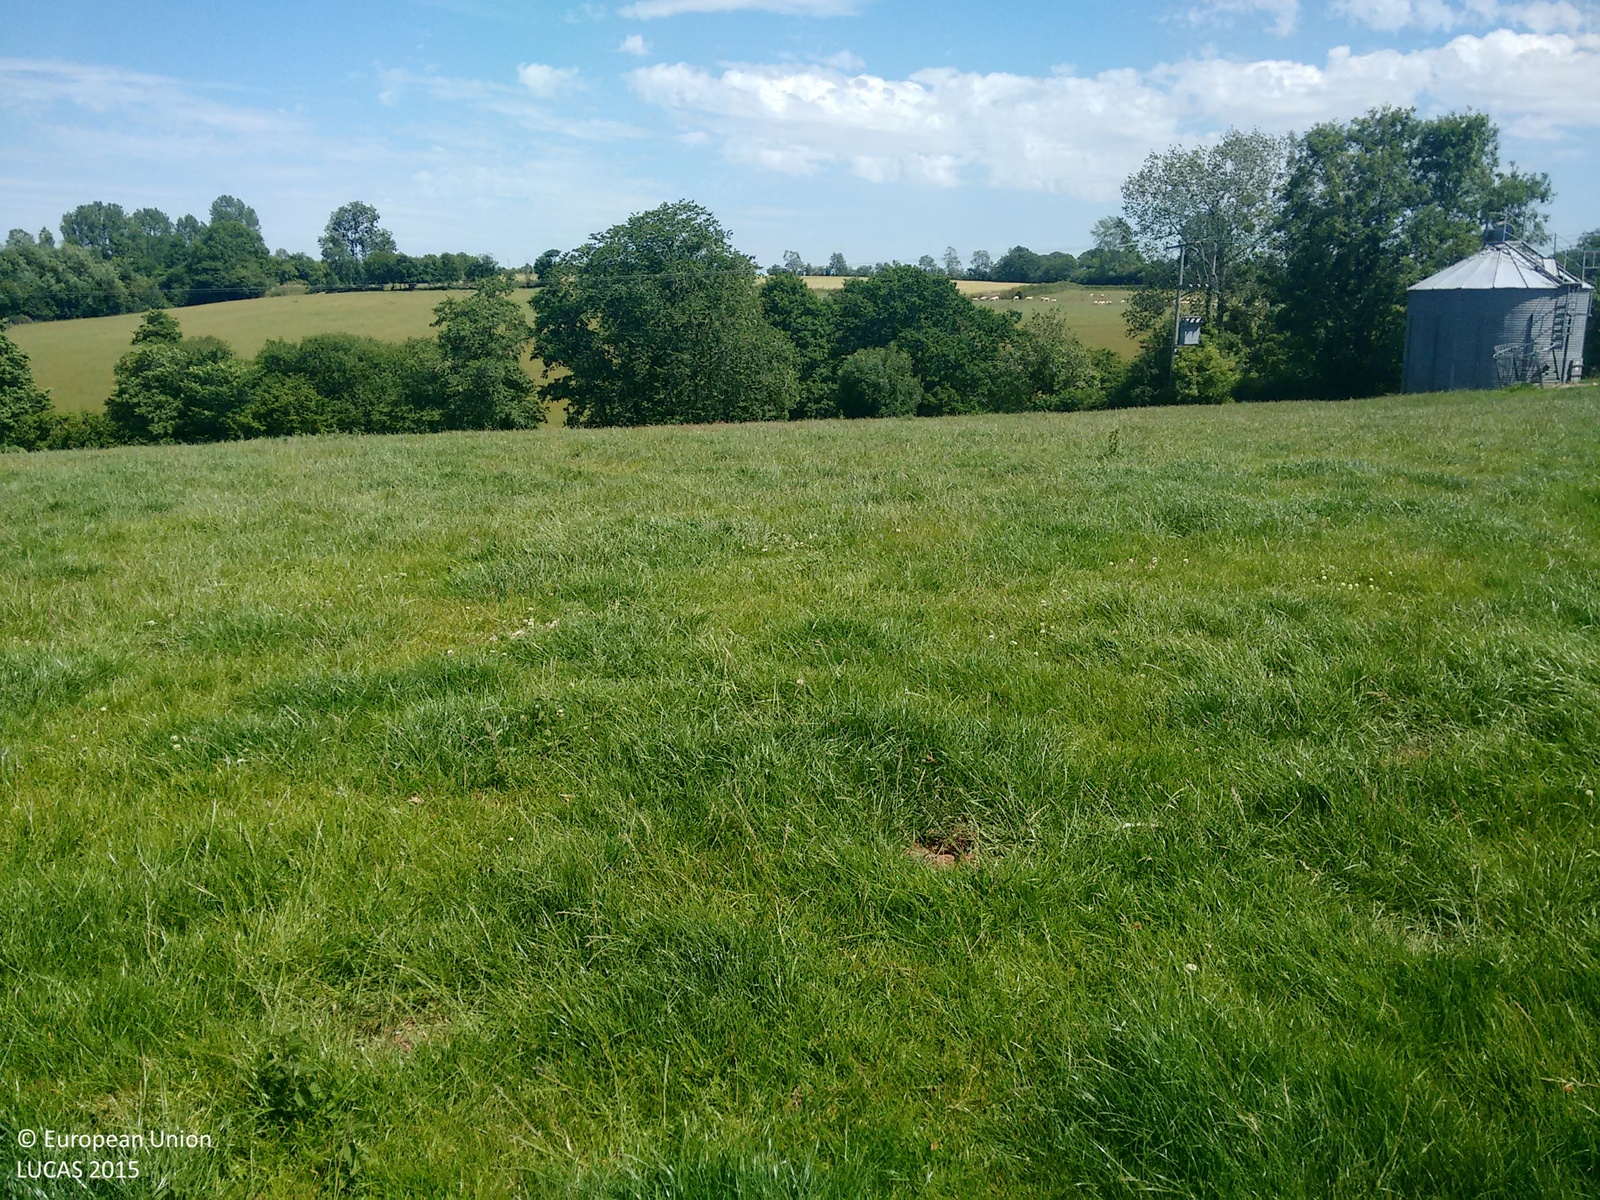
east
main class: Grassland
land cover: Grassland without tree/shrub cover
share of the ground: > 75 %
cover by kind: herbaceous plants 100 %
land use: Agriculture (excluding fallow land and kitchen gardens)
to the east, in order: Grassland without tree/shrub cover; Electric lines; Grassland without tree/shrub cover; Fences; Managed hedges; Ditches and canals; Fences; Grassland without tree/shrub cover; Fences; Broadleaved woodland; Inland fresh running water; Broadleaved woodland; Fences; Grassland without tree/shrub cover
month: July
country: GB
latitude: 52.1906
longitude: -2.6342
